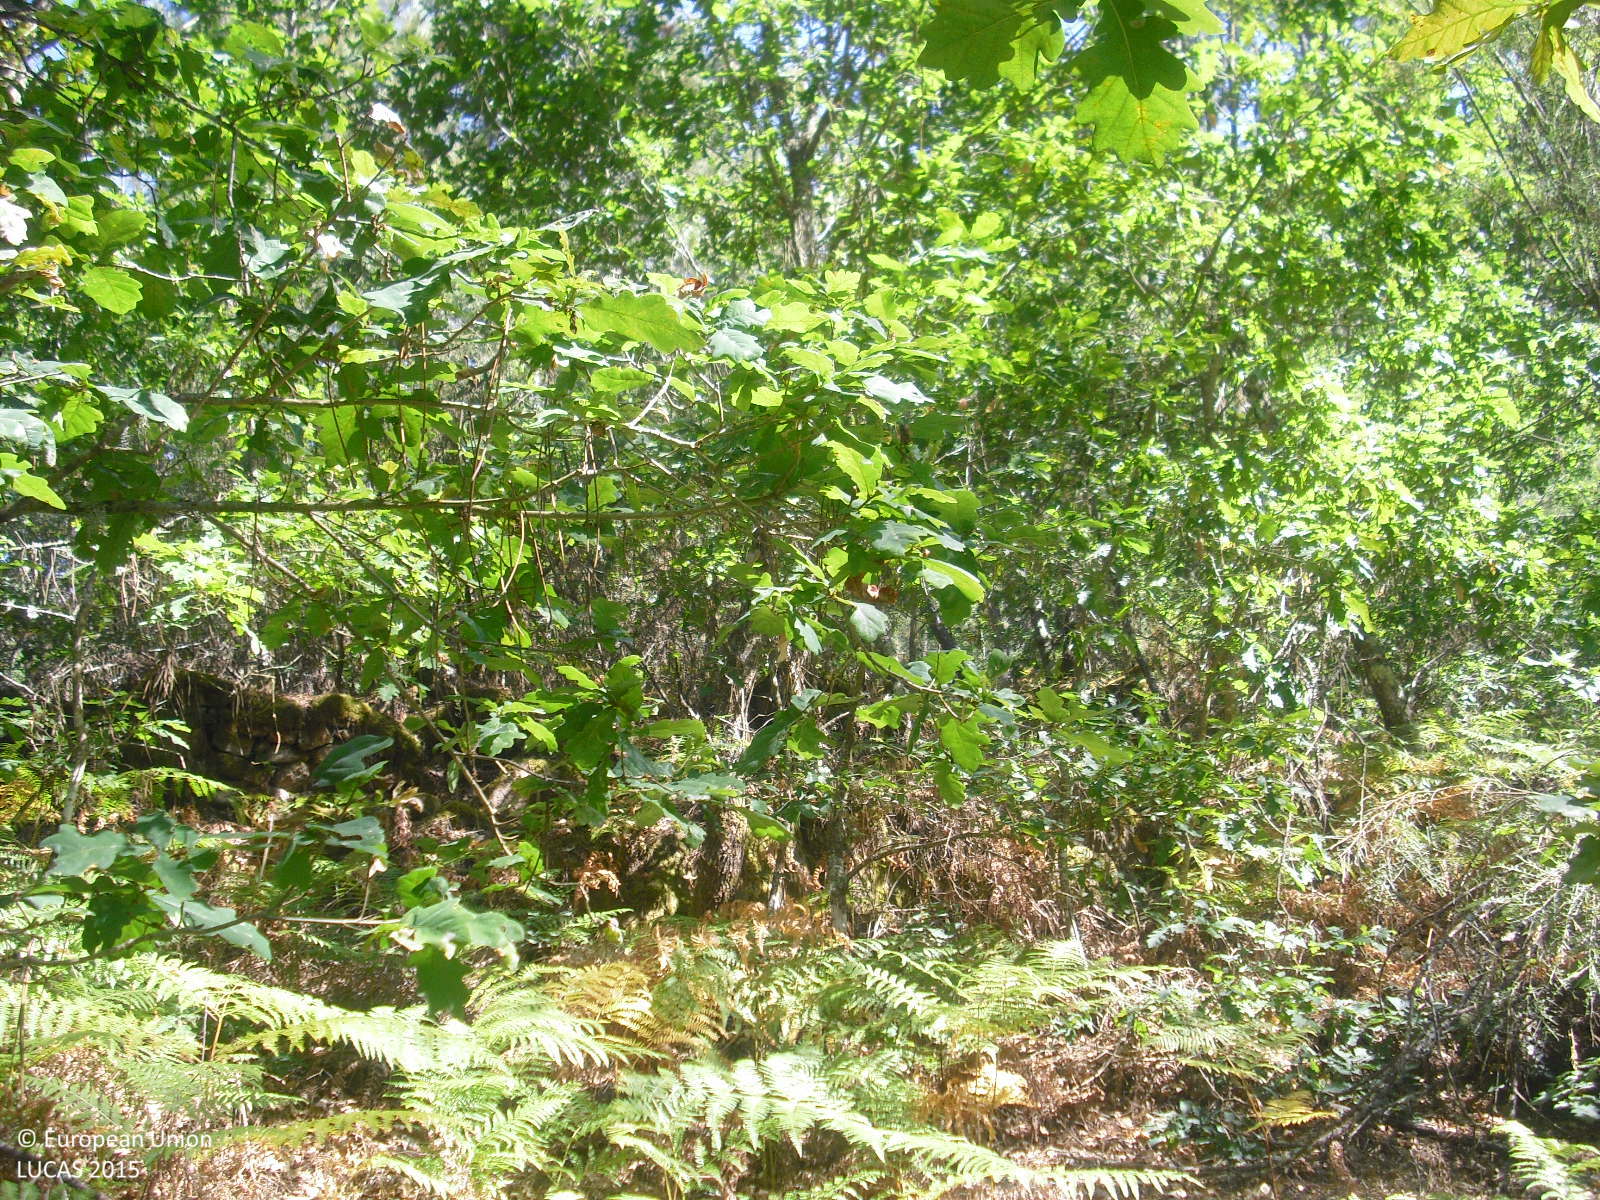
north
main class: Woodland
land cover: Pine dominated mixed woodland
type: hemiboreal forest and nemoral coniferous forest and mixed broadleaved-coniferous forest
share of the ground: > 75 %
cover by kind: coniferous forest trees 50 %, shrubs 30 %, broadleaved forest trees 20 %
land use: Forestry
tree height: > 5 m
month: June
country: ES
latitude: 42.4299
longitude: -7.7859
